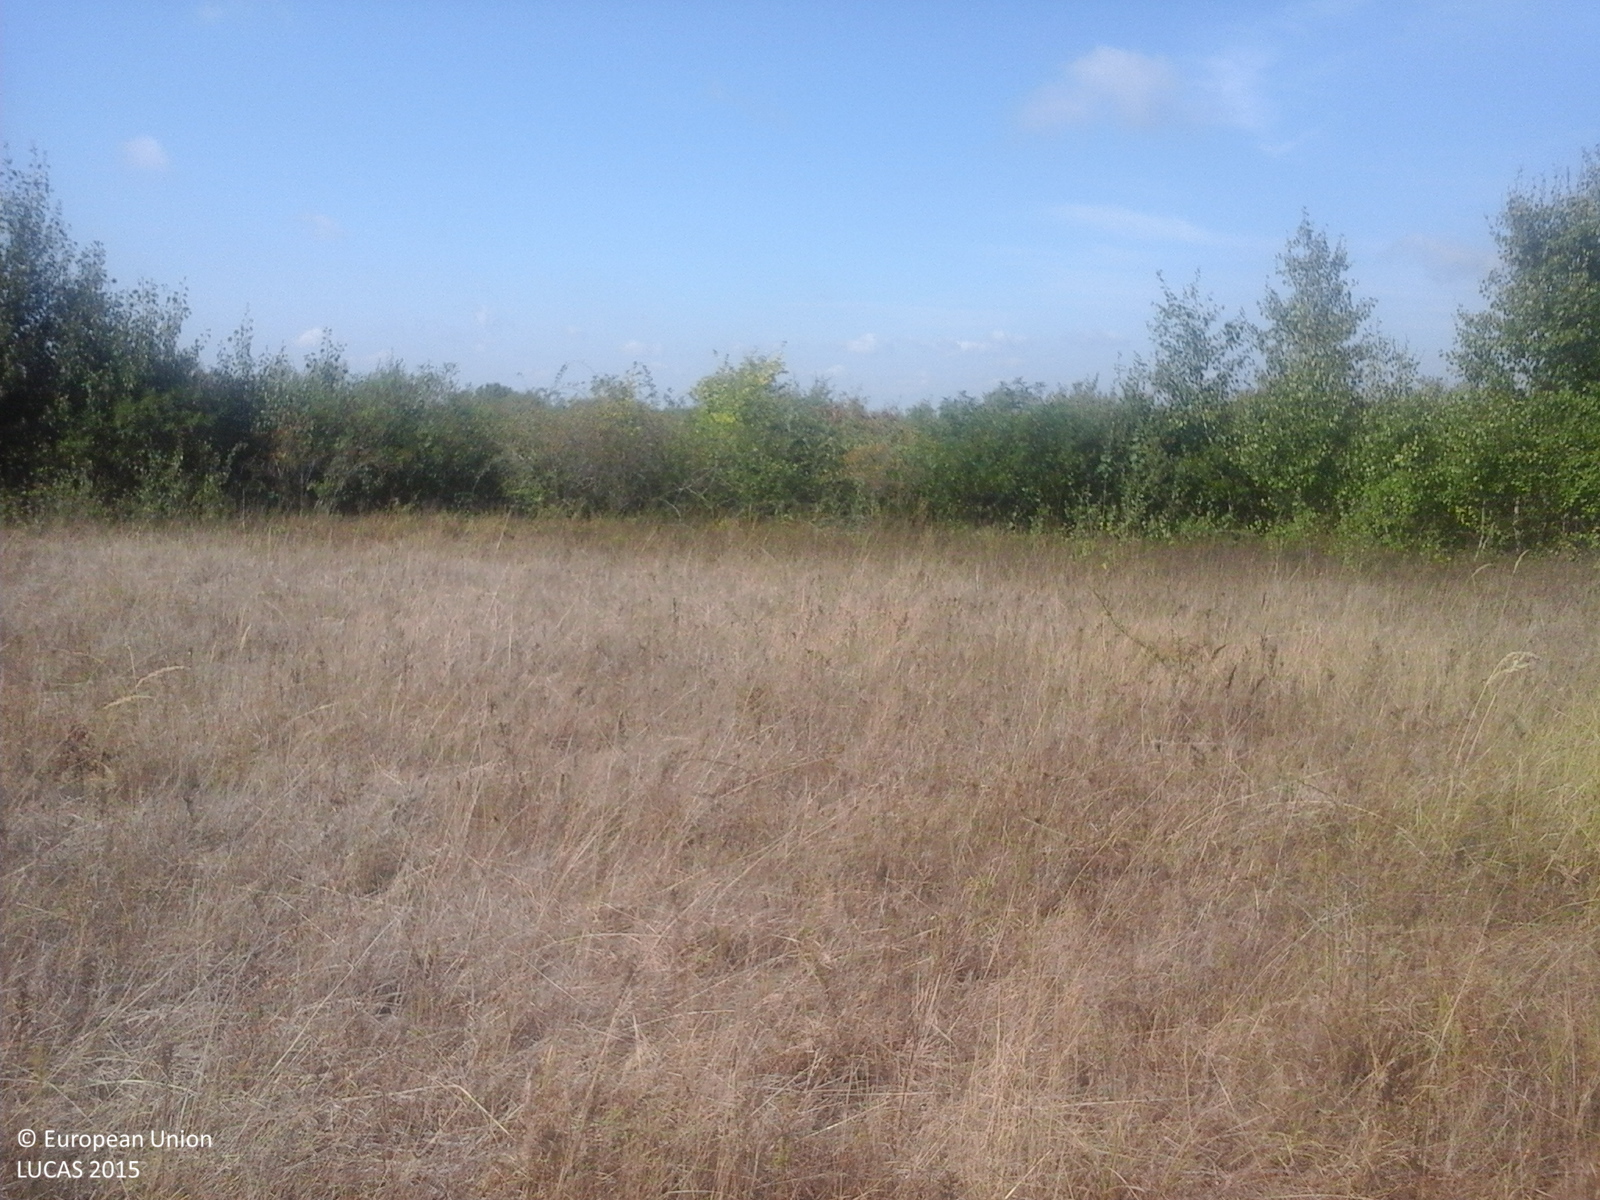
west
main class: Grassland
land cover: Spontaneously vegetated surfaces
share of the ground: > 75 %
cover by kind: herbaceous plants 100 %
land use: Fallow land
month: September
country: RO
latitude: 47.9226
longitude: 23.0085
